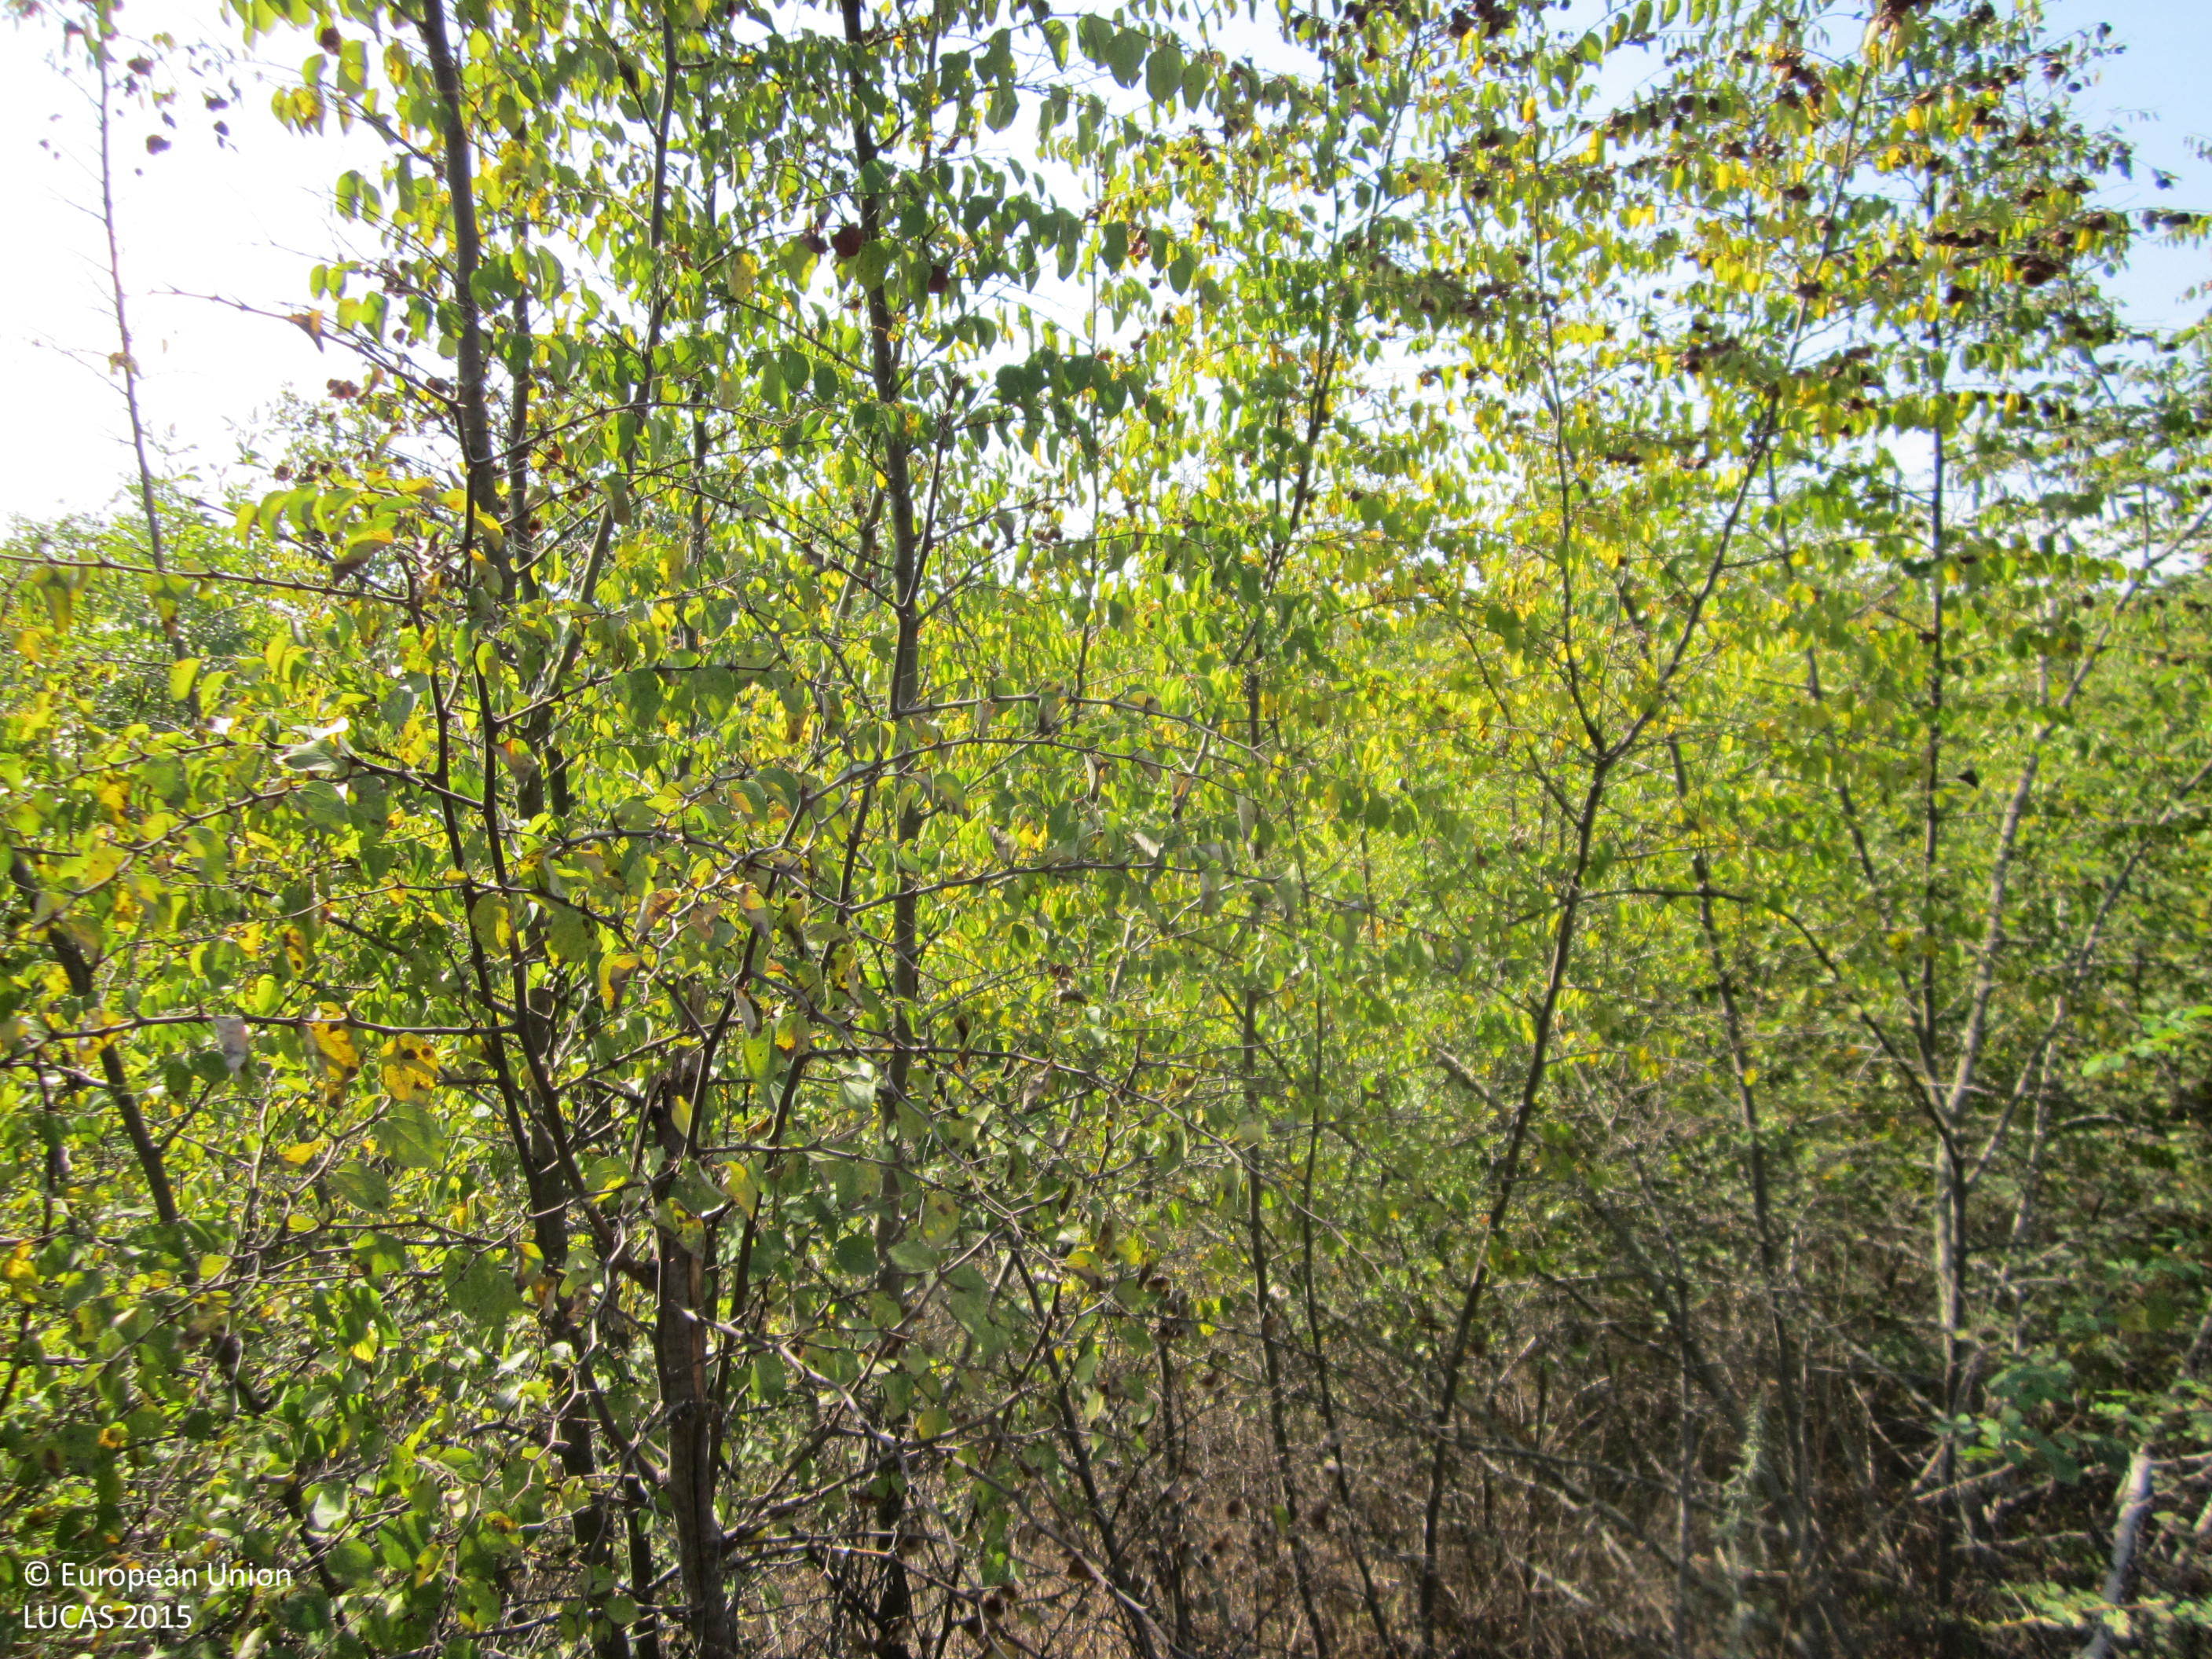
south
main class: Shrubland
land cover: Shrubland with sparse tree cover
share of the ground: > 75 %
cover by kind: shrubs 85 %, broadleaved forest trees 5 %, herbaceous plants 5 %, consolidated bare surface 5 %
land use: Semi-natural and natural areas not in use
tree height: < 5 m
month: September
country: BG
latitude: 42.1983
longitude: 27.7409
